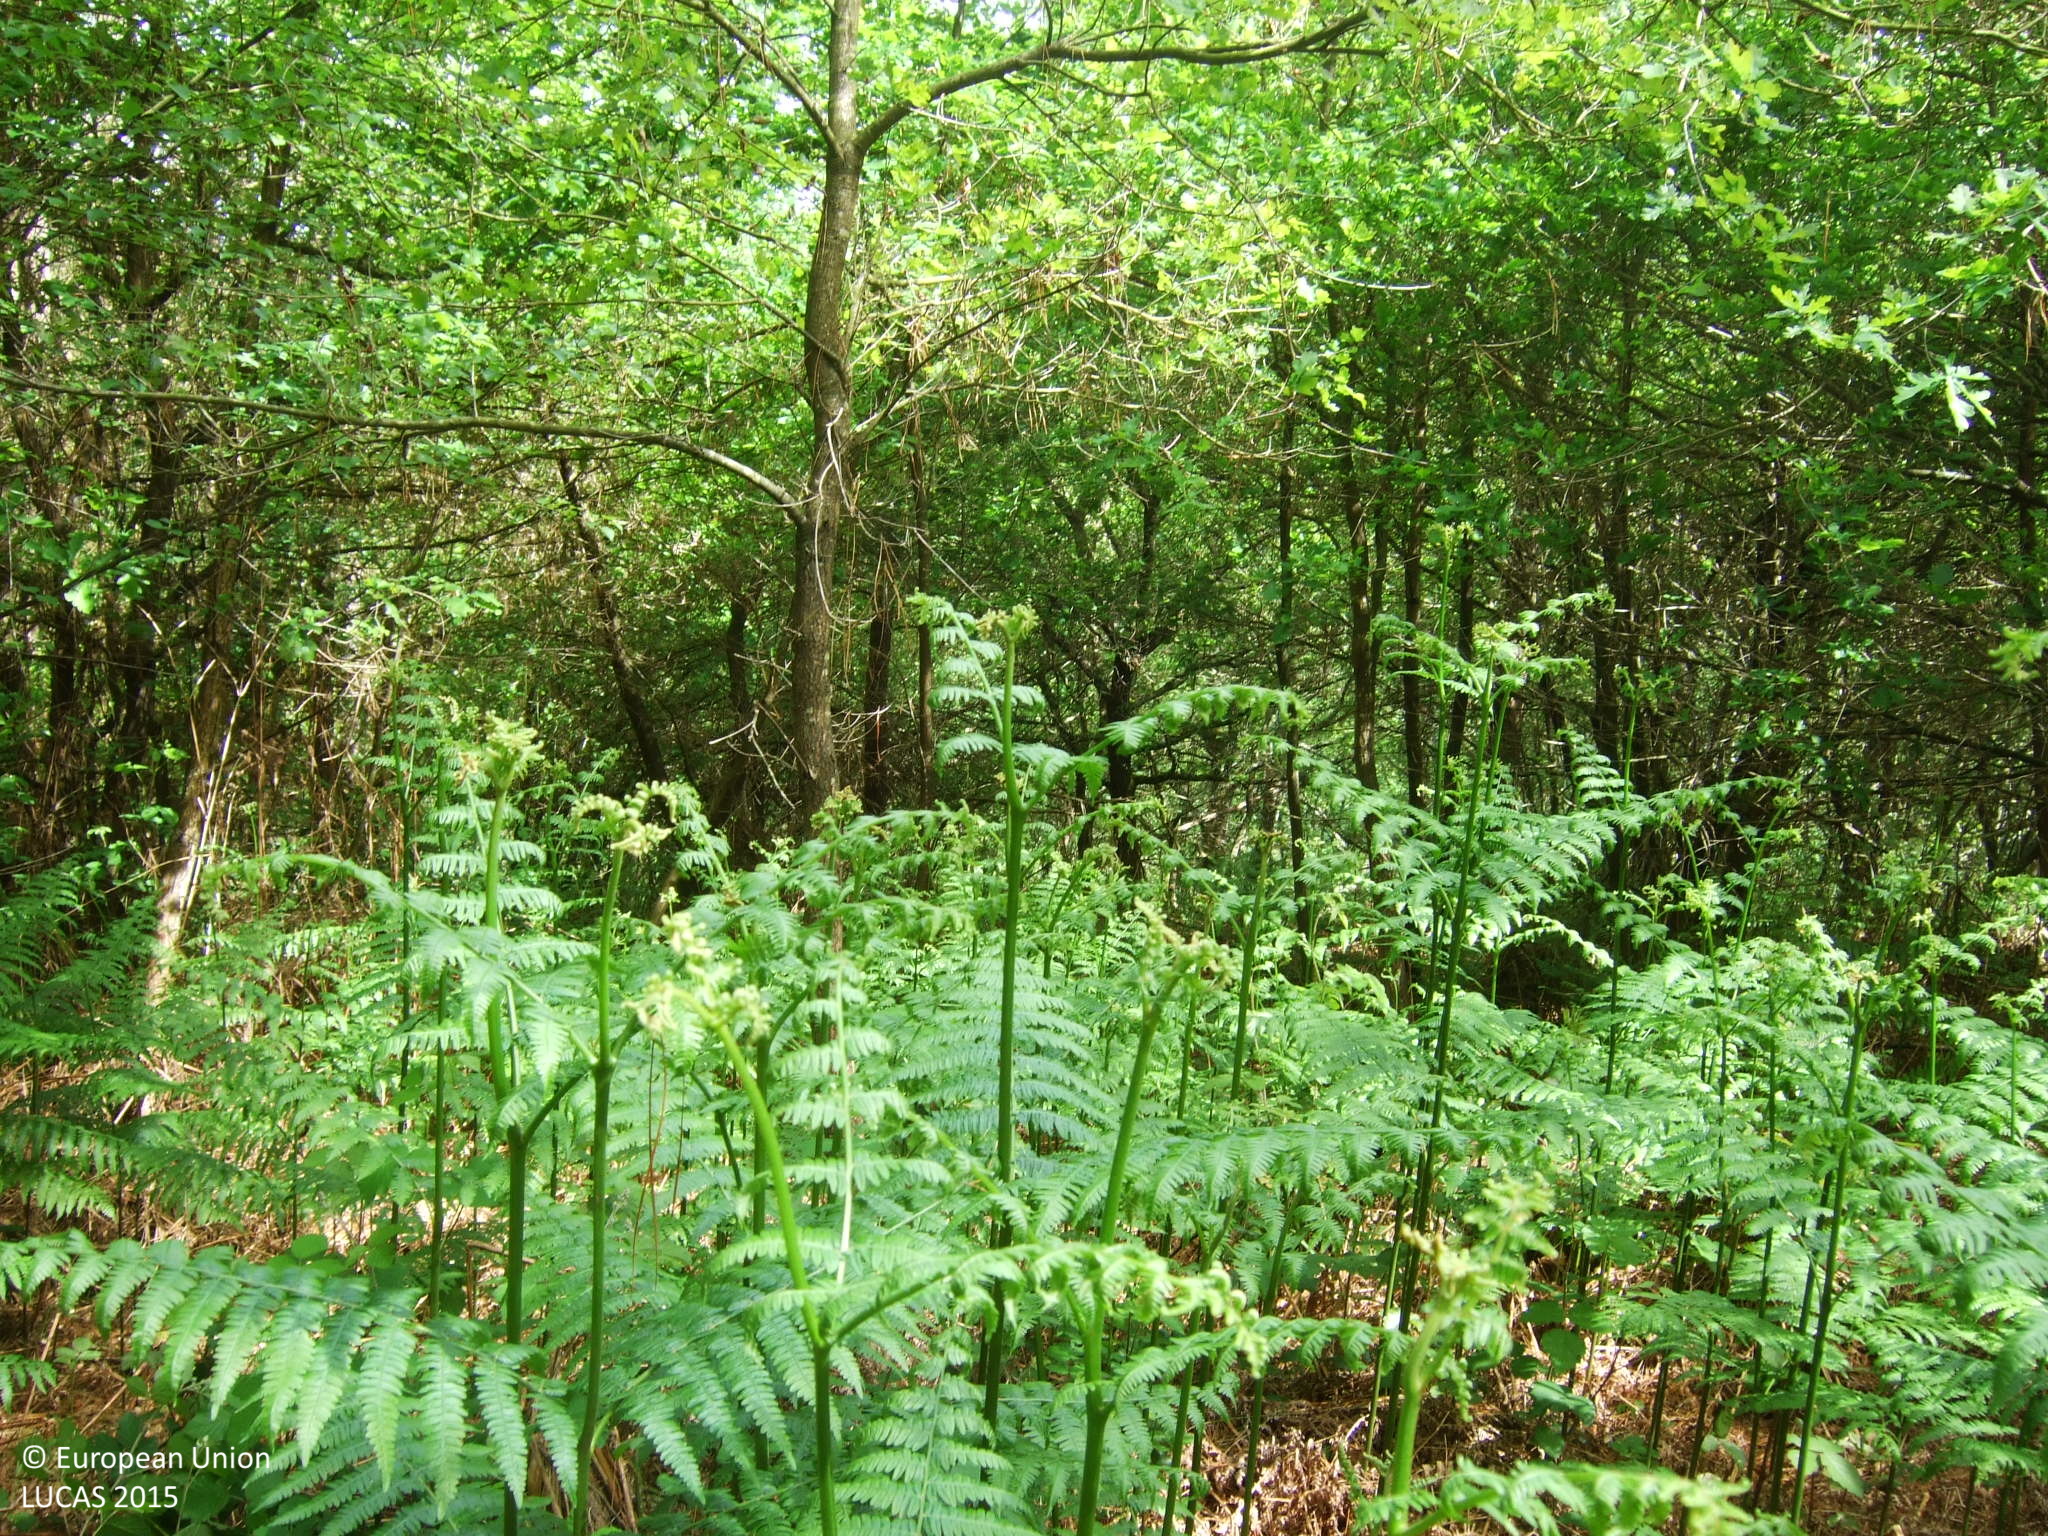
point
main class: Woodland
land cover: Broadleaved woodland
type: acidophilous oak and oak-birch forest
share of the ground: > 75 %
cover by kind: broadleaved forest trees 90 %, shrubs 10 %
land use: Forestry
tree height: > 5 m
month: May
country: ES
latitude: 42.9073
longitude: -7.3779
